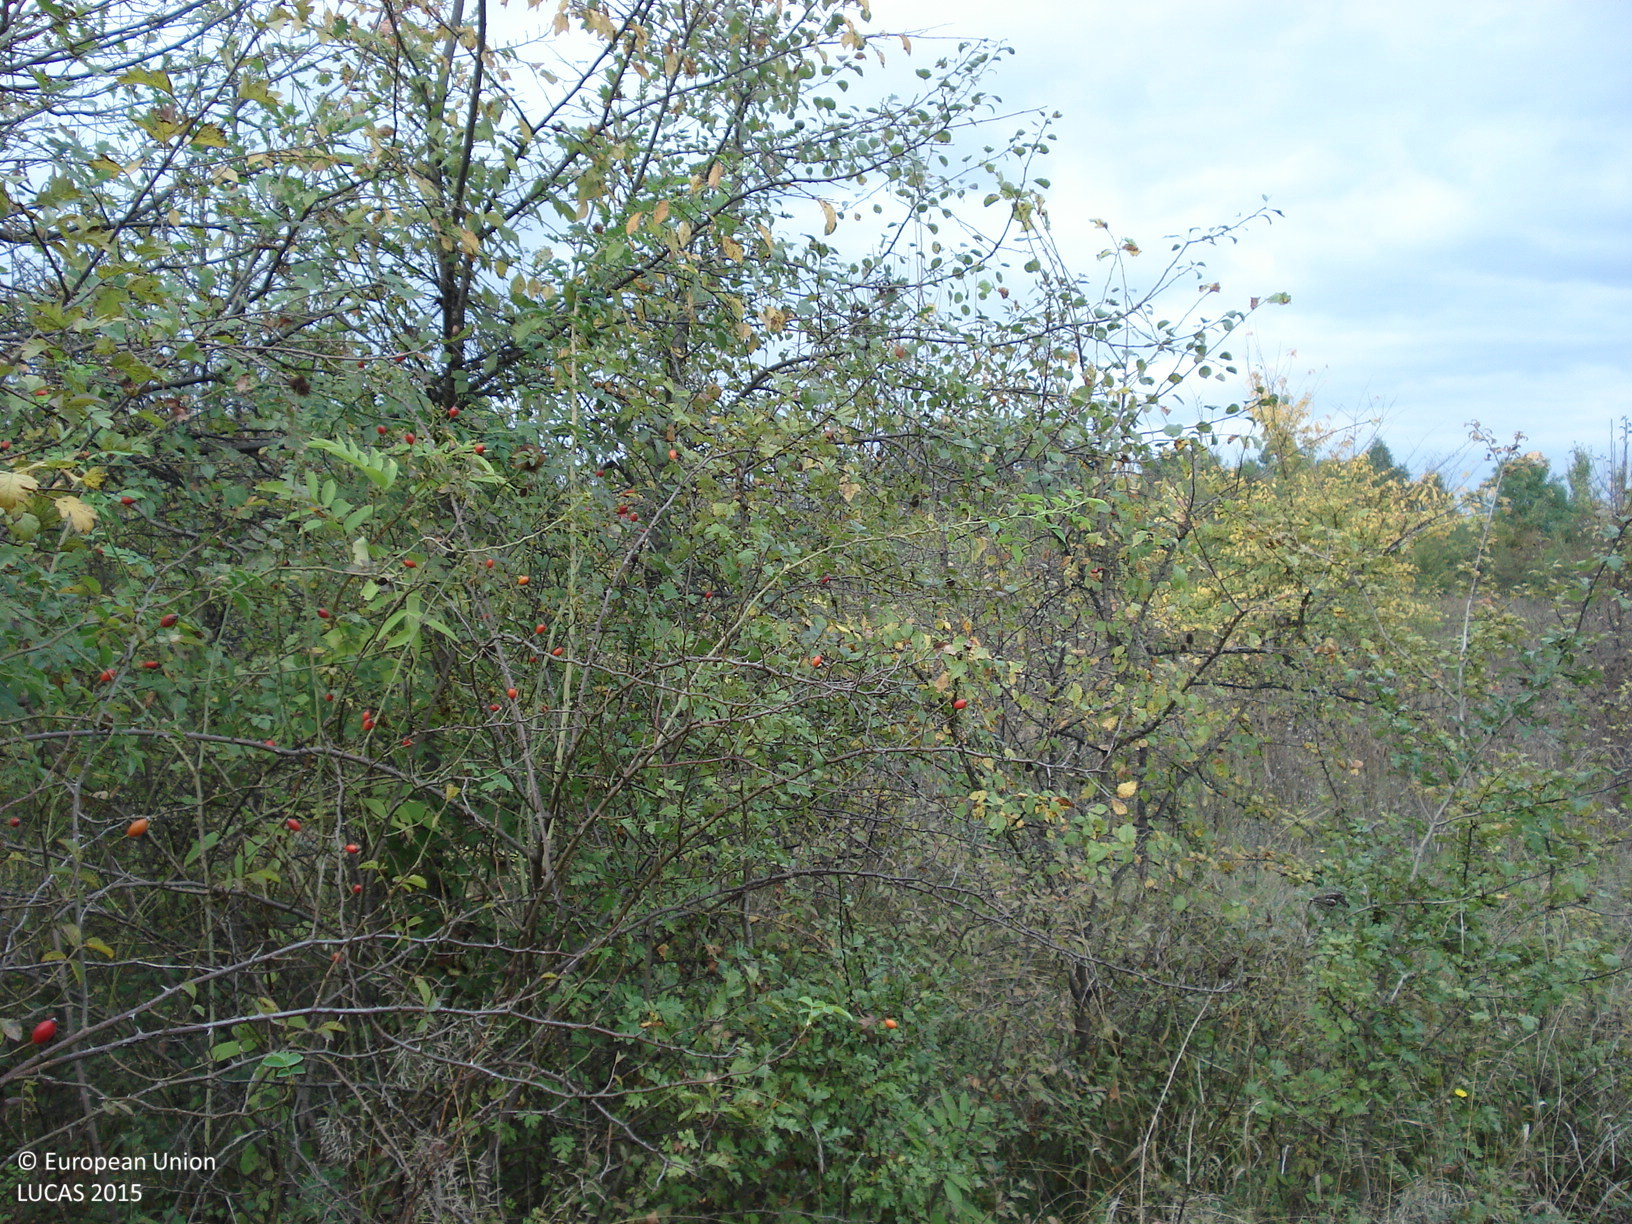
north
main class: Woodland
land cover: Broadleaved woodland
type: mesophytic deciduous forest
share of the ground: > 75 %
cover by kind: broadleaved forest trees 80 %, shrubs 10 %, herbaceous plants 10 %
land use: Forestry
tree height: > 5 m
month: October
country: BG
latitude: 42.9928
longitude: 25.7439
